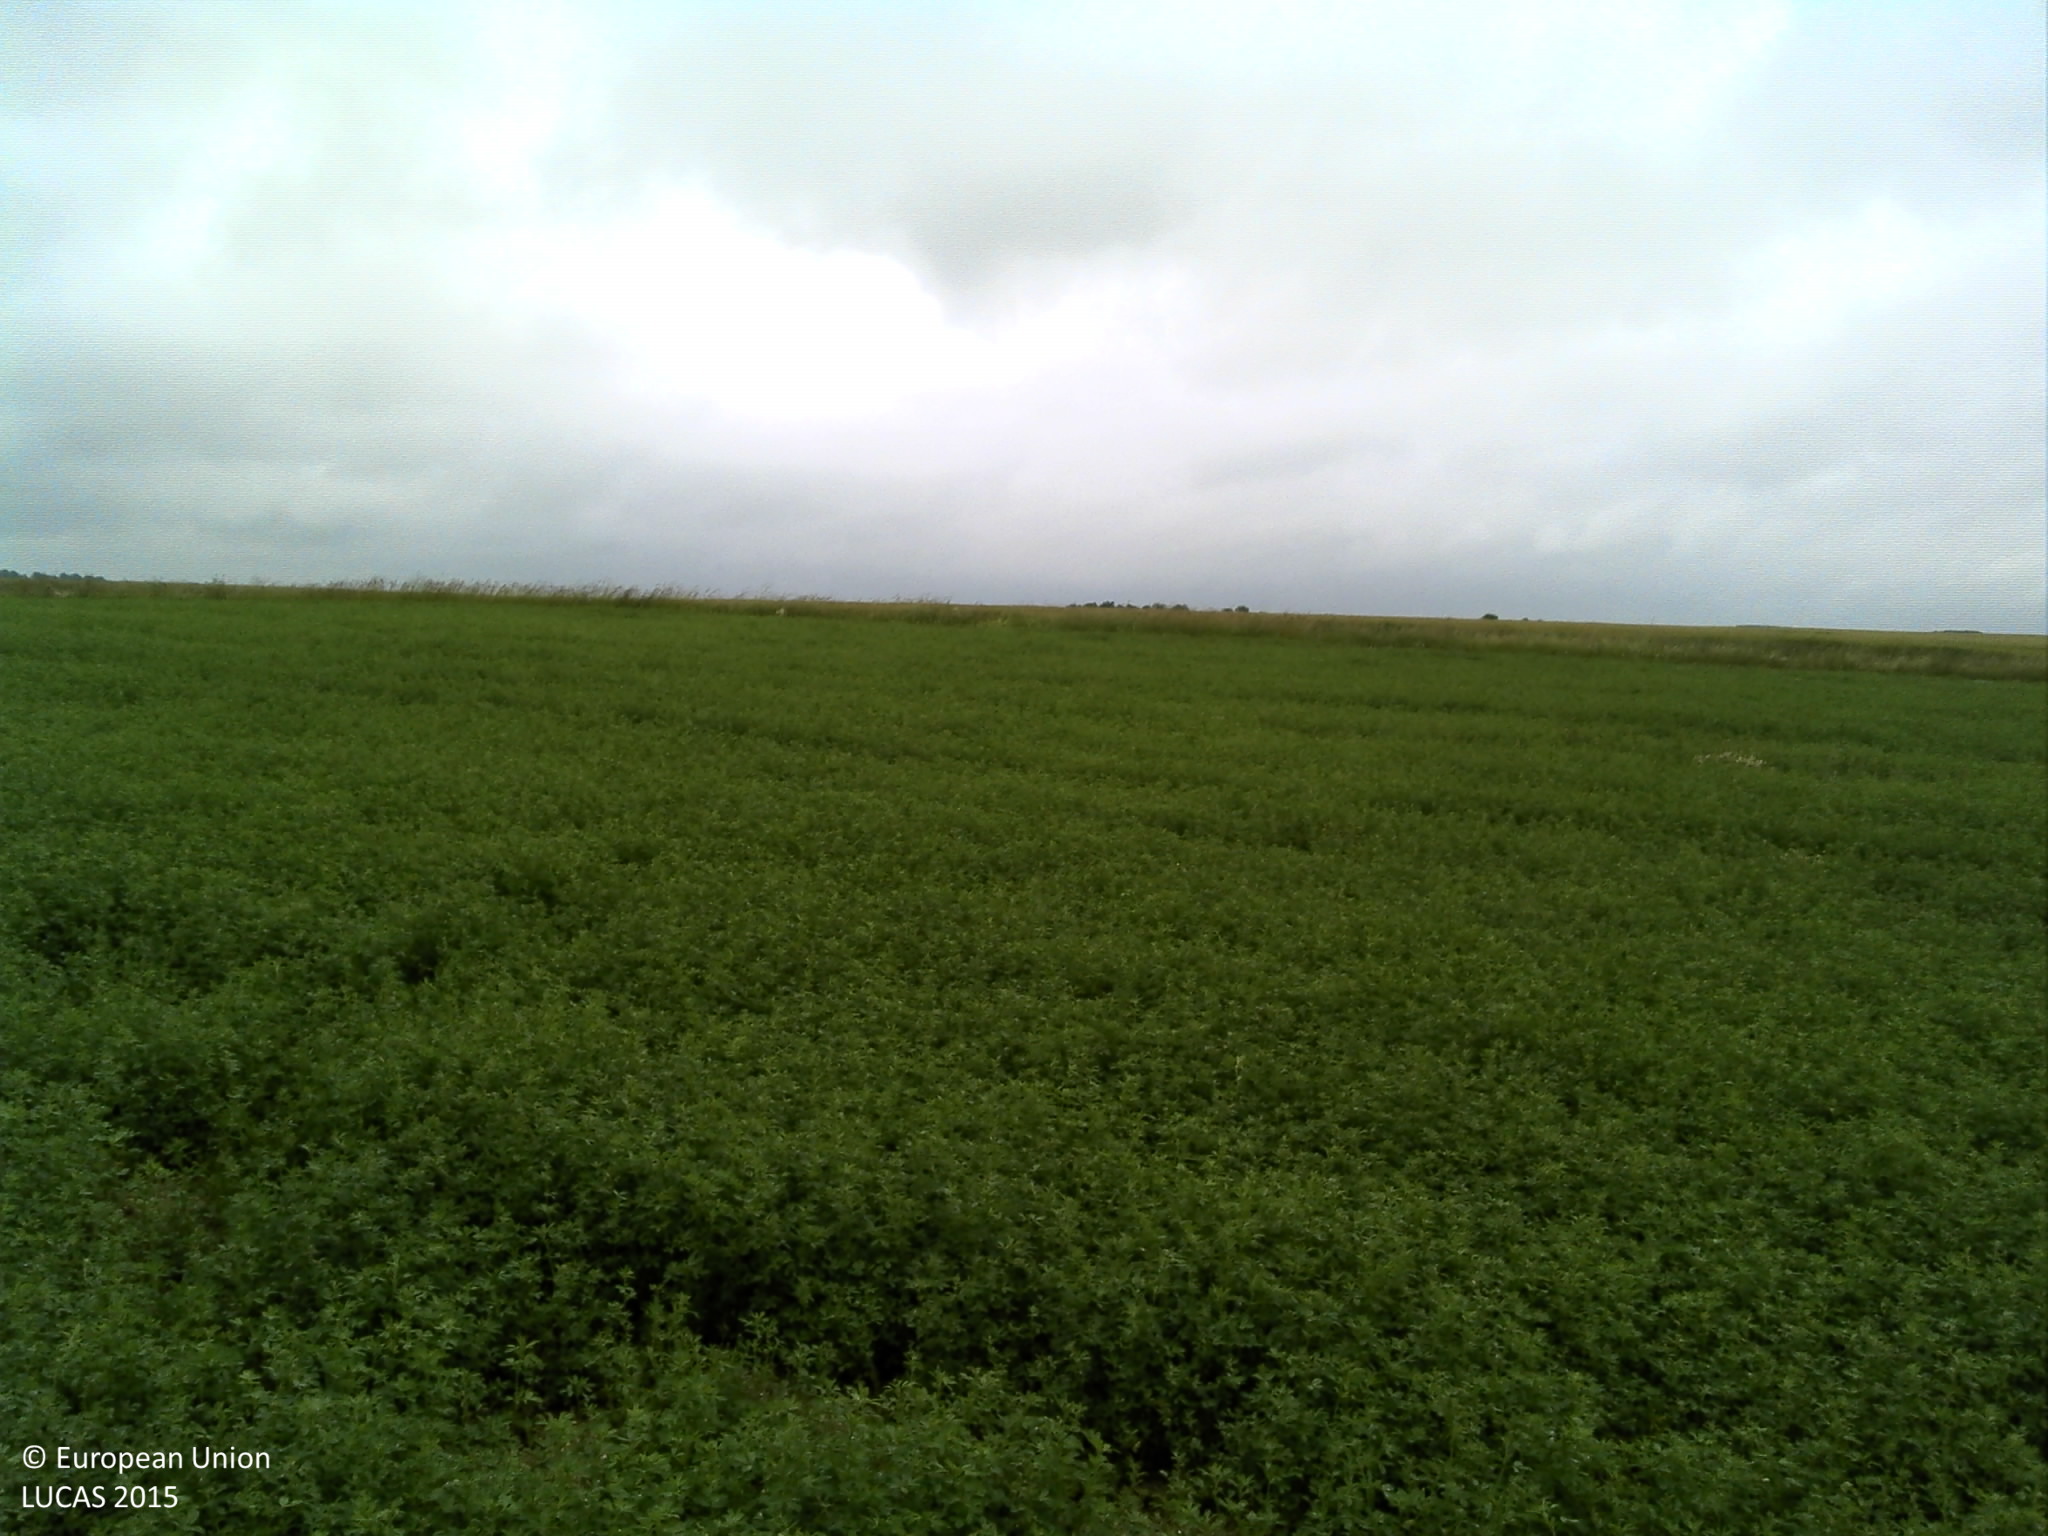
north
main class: Cropland
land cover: Lucerne
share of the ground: > 75 %
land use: Agriculture (excluding fallow land and kitchen gardens)
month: June
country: FR
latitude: 48.6302
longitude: 4.2025
